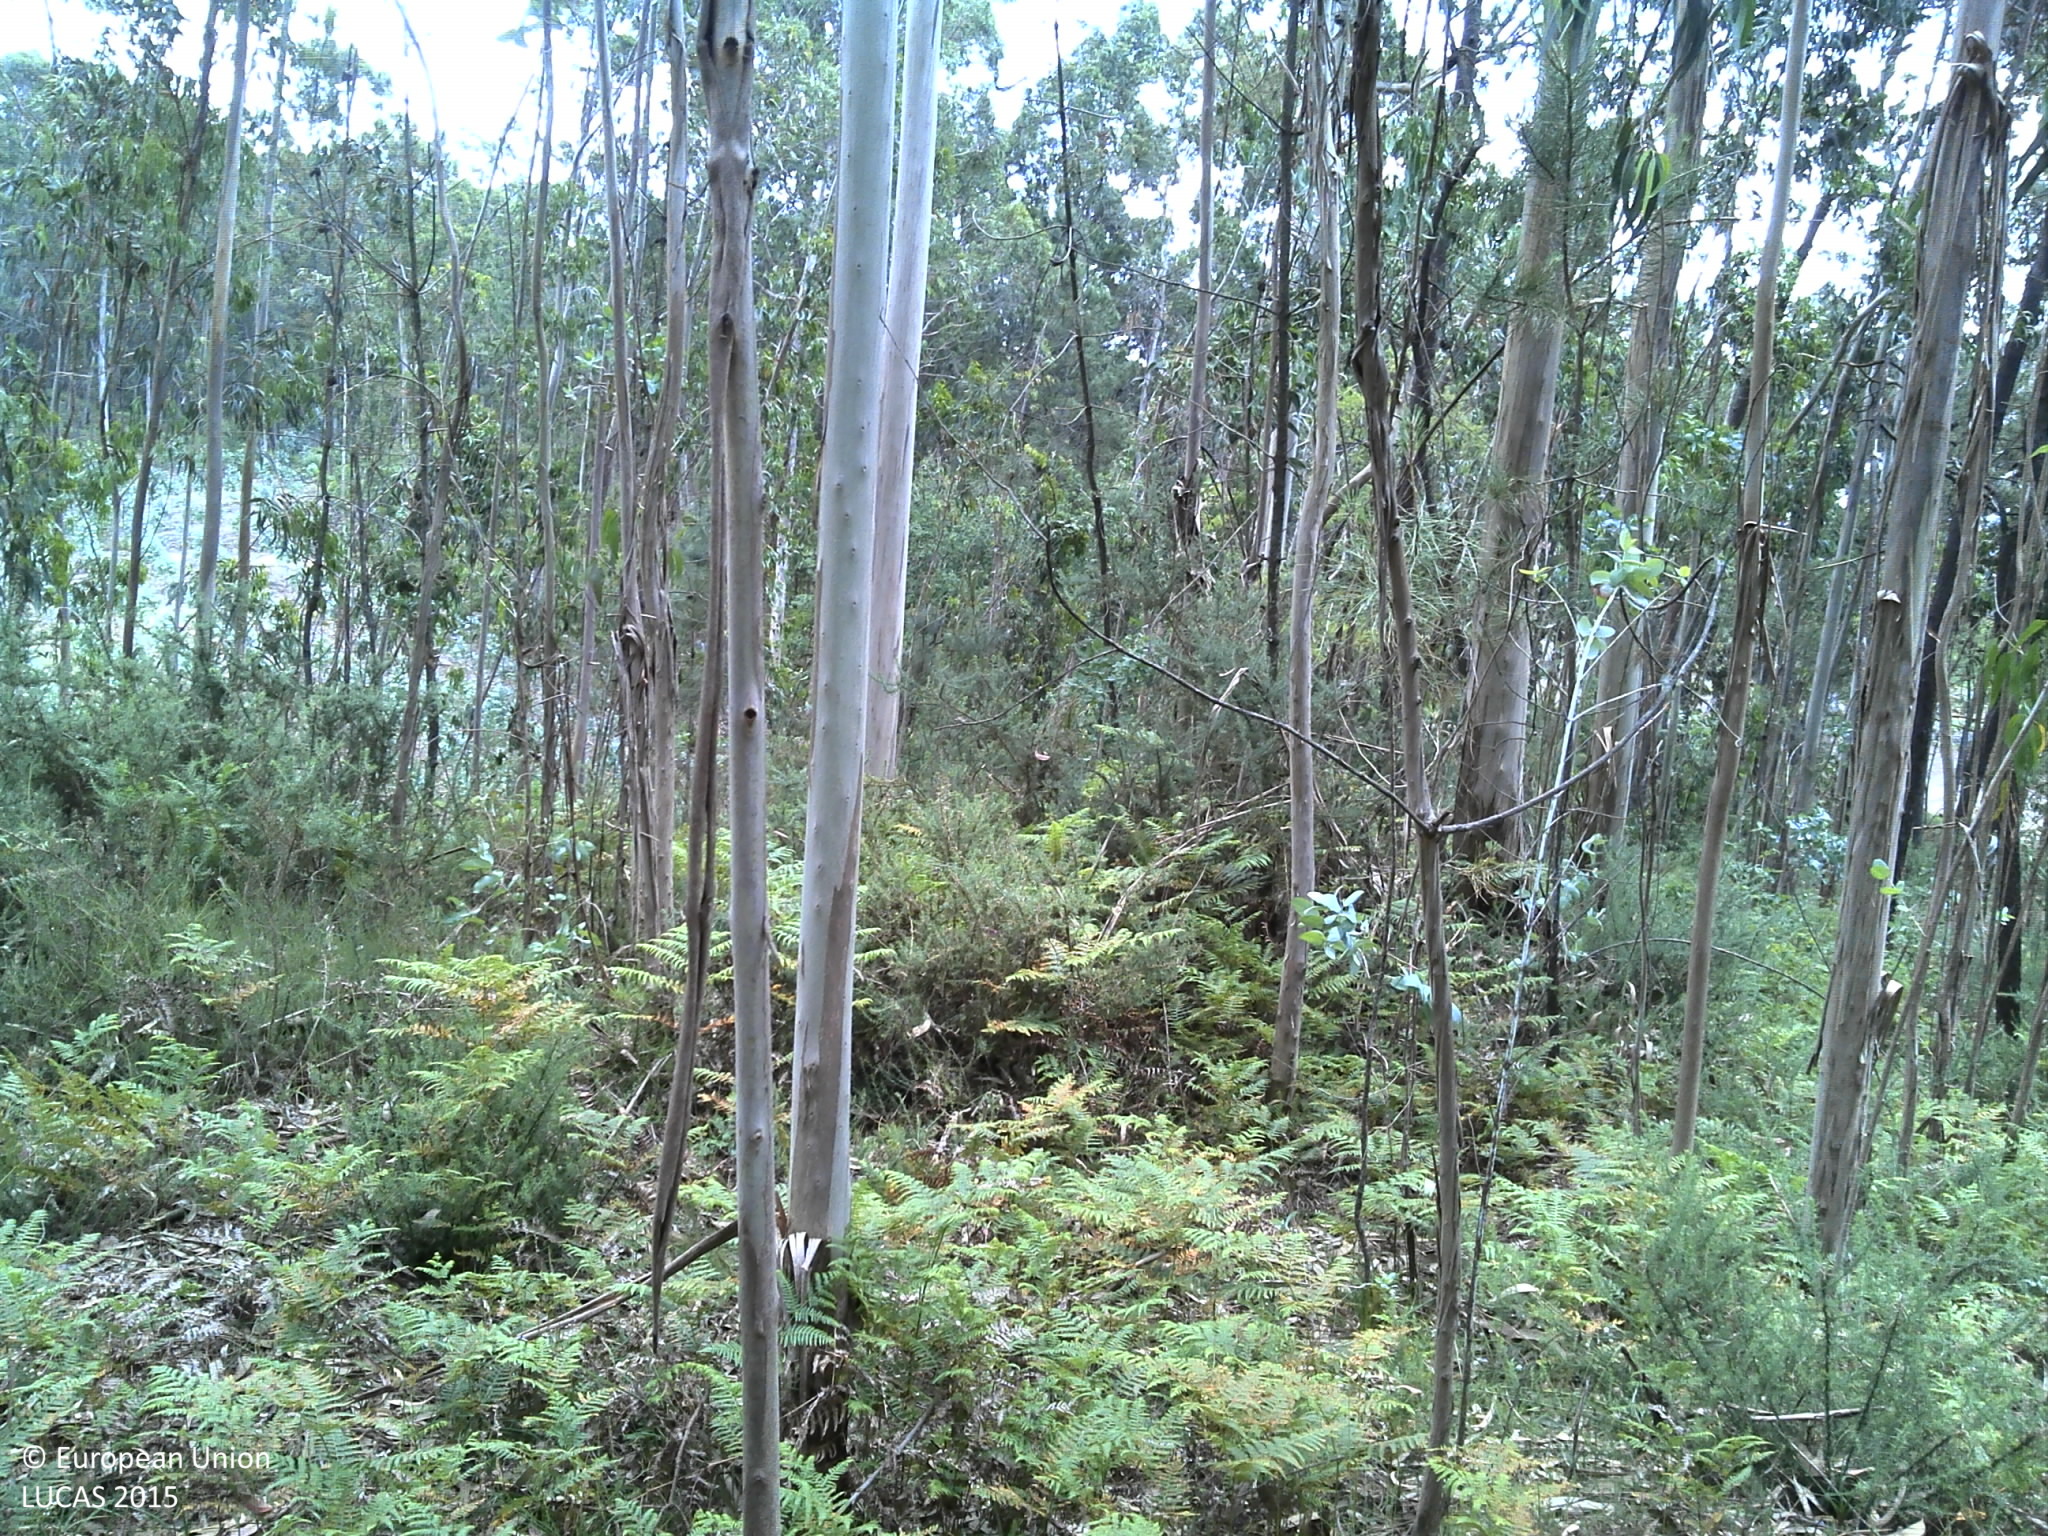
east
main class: Woodland
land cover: Broadleaved woodland
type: exotic forest
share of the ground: > 75 %
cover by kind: broadleaved forest trees 70 %, shrubs 20 %, herbaceous plants 5 %, unconsolidated bare surface 5 %
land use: Forestry
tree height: > 5 m
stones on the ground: < 10 %
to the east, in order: Broadleaved woodland; Tracks; Broadleaved woodland; Dry stone walls; Broadleaved woodland; Pine dominated mixed woodland; Dry stone walls; Tracks; Dry stone walls; Pine dominated mixed woodland; Artificial constructions in urban areas; Pine dominated coniferous woodland
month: May
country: PT
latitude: 41.4571
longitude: -8.6553
